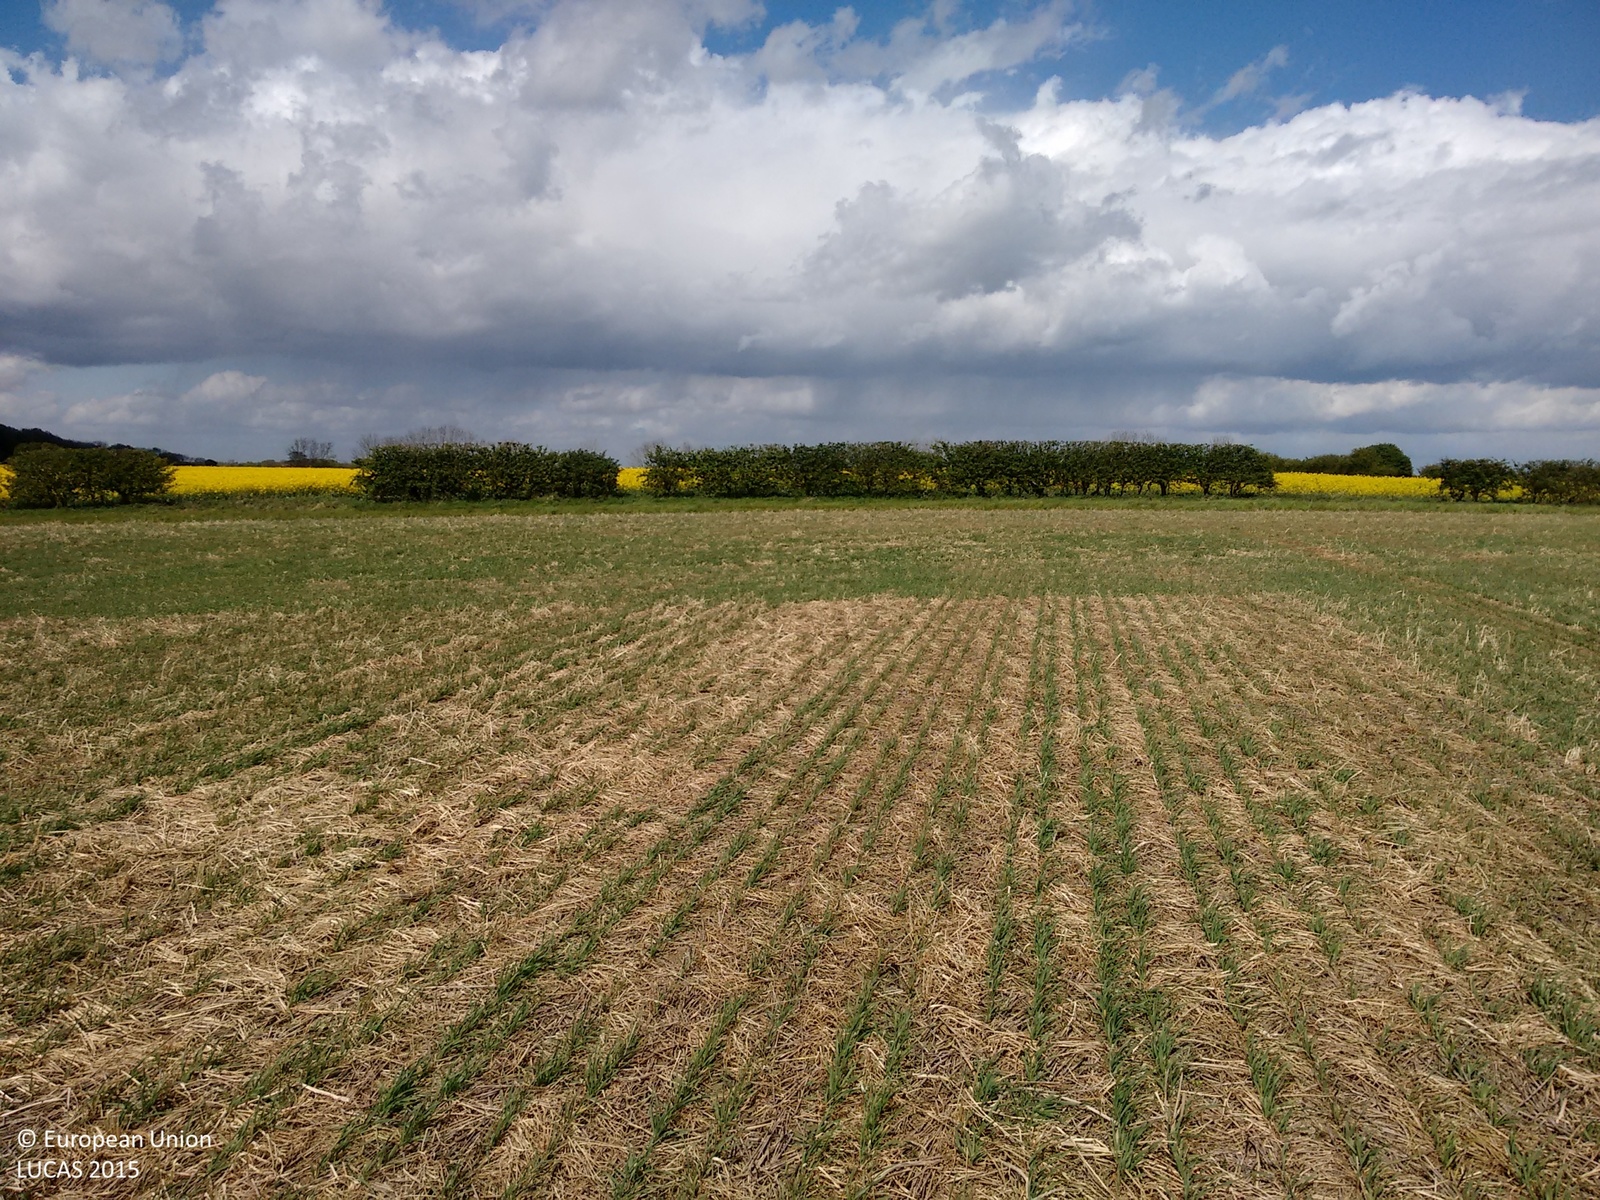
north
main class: Cropland
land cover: Barley
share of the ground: 25 - 50 %
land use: Agriculture (excluding fallow land and kitchen gardens)
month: May
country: GB
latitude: 53.8630
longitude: -0.1446
